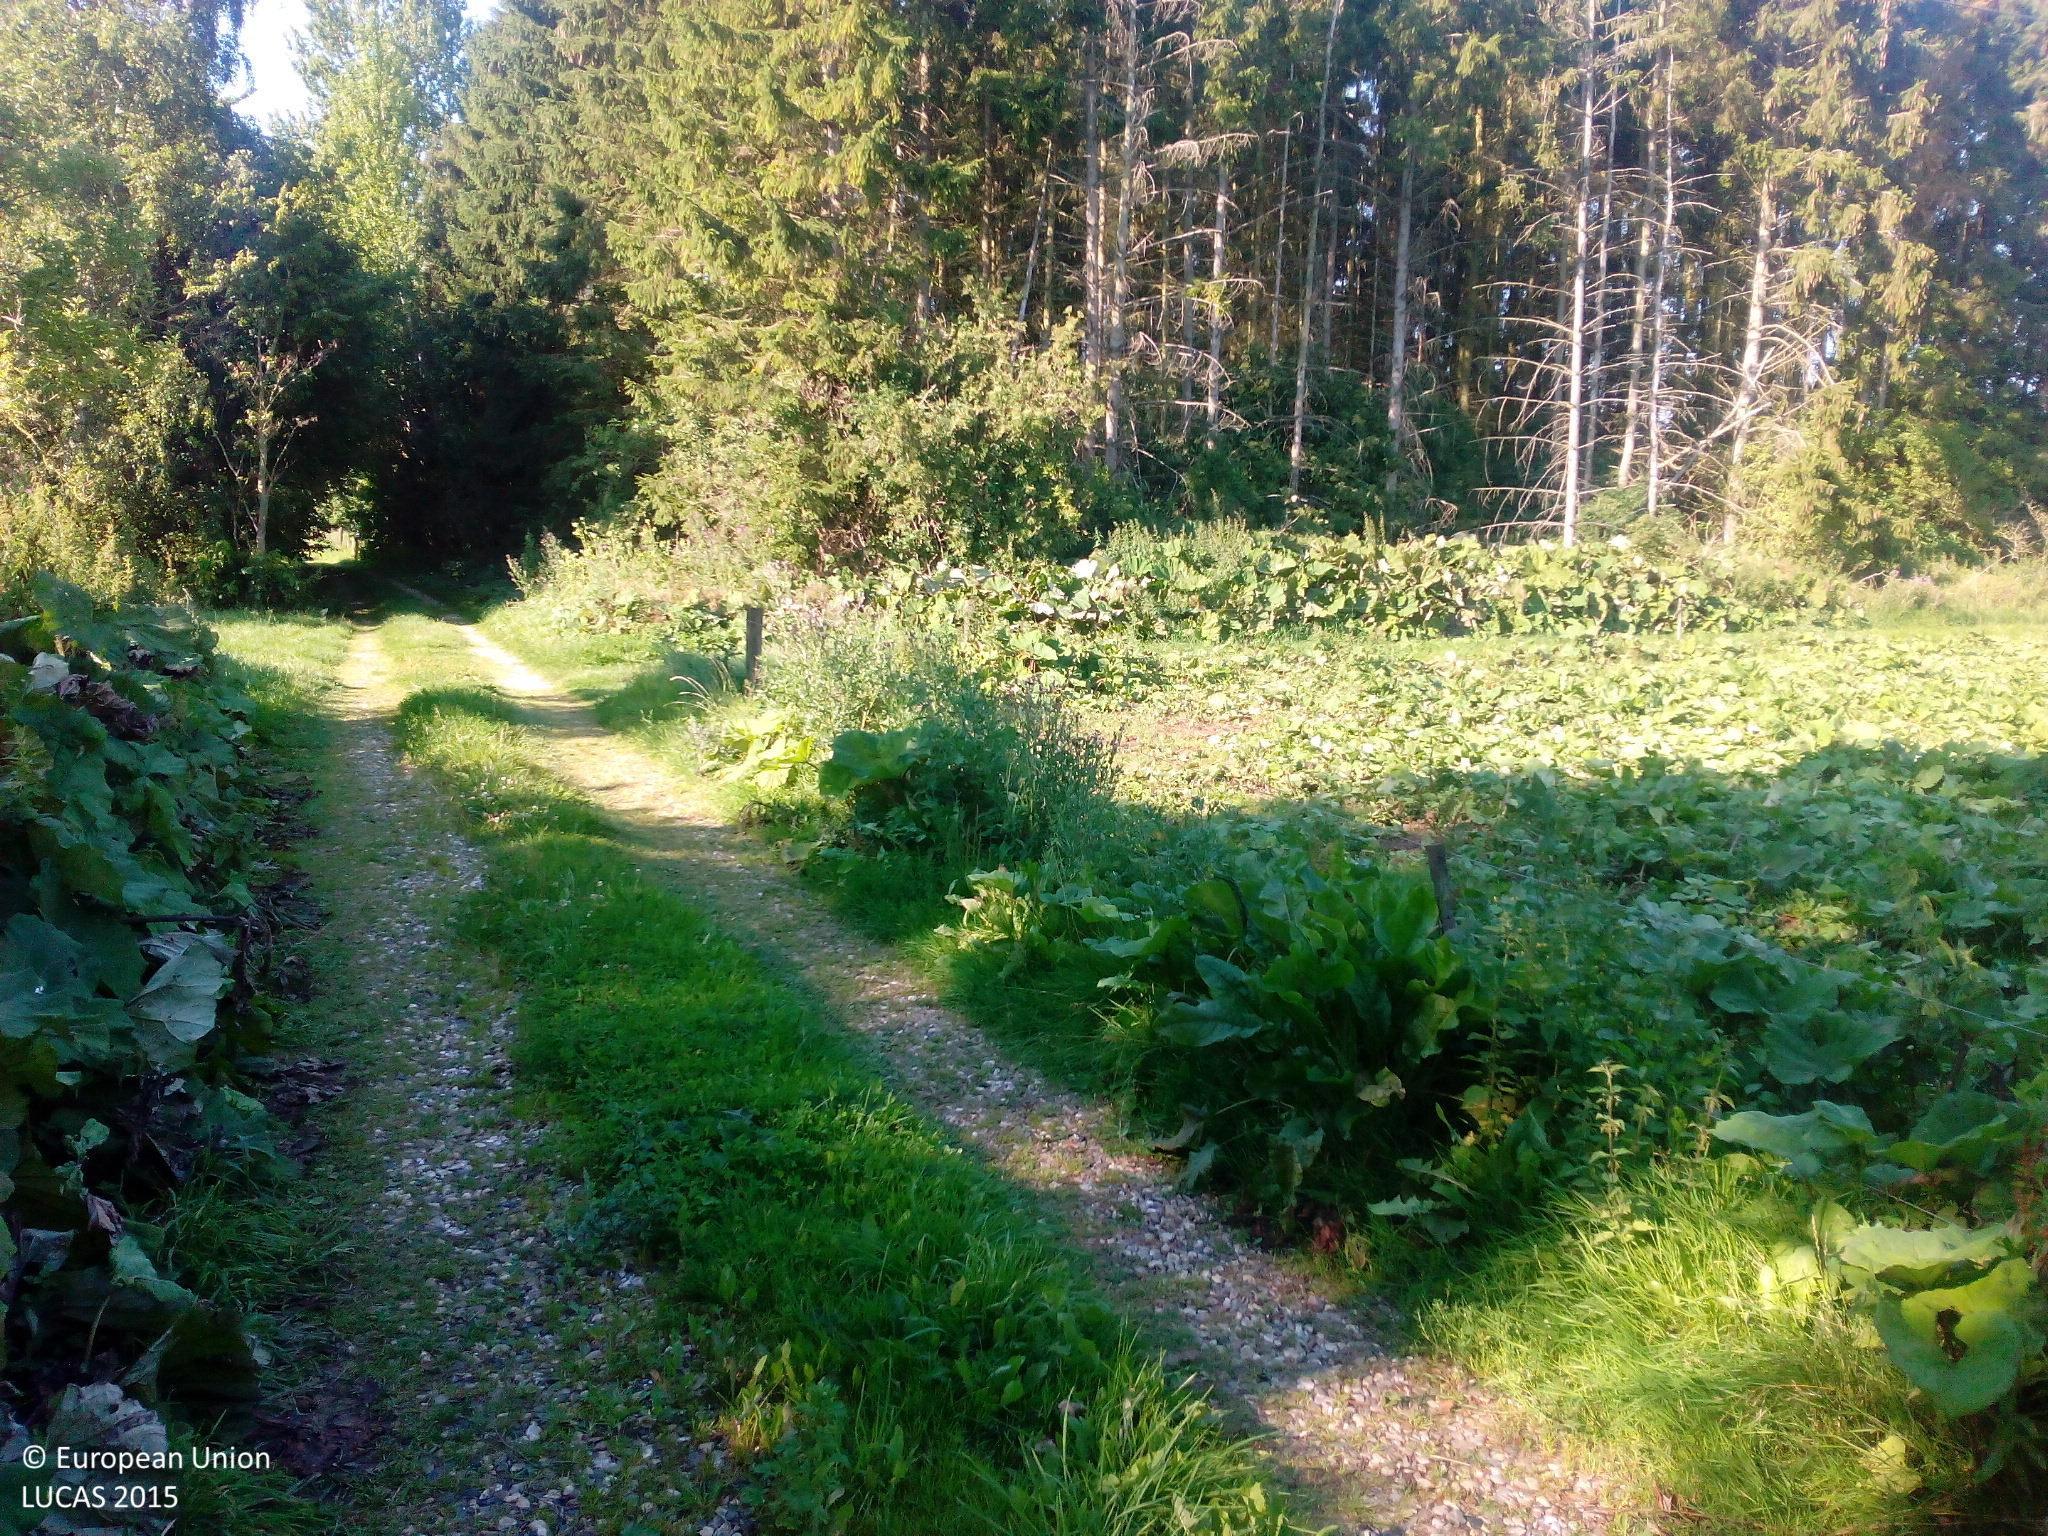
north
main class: Woodland
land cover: Spruce dominated coniferous woodland
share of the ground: > 75 %
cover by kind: coniferous forest trees 80 %, broadleaved forest trees 20 %
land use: Semi-natural and natural areas not in use
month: August
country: DK
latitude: 55.6358
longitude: 11.7935
